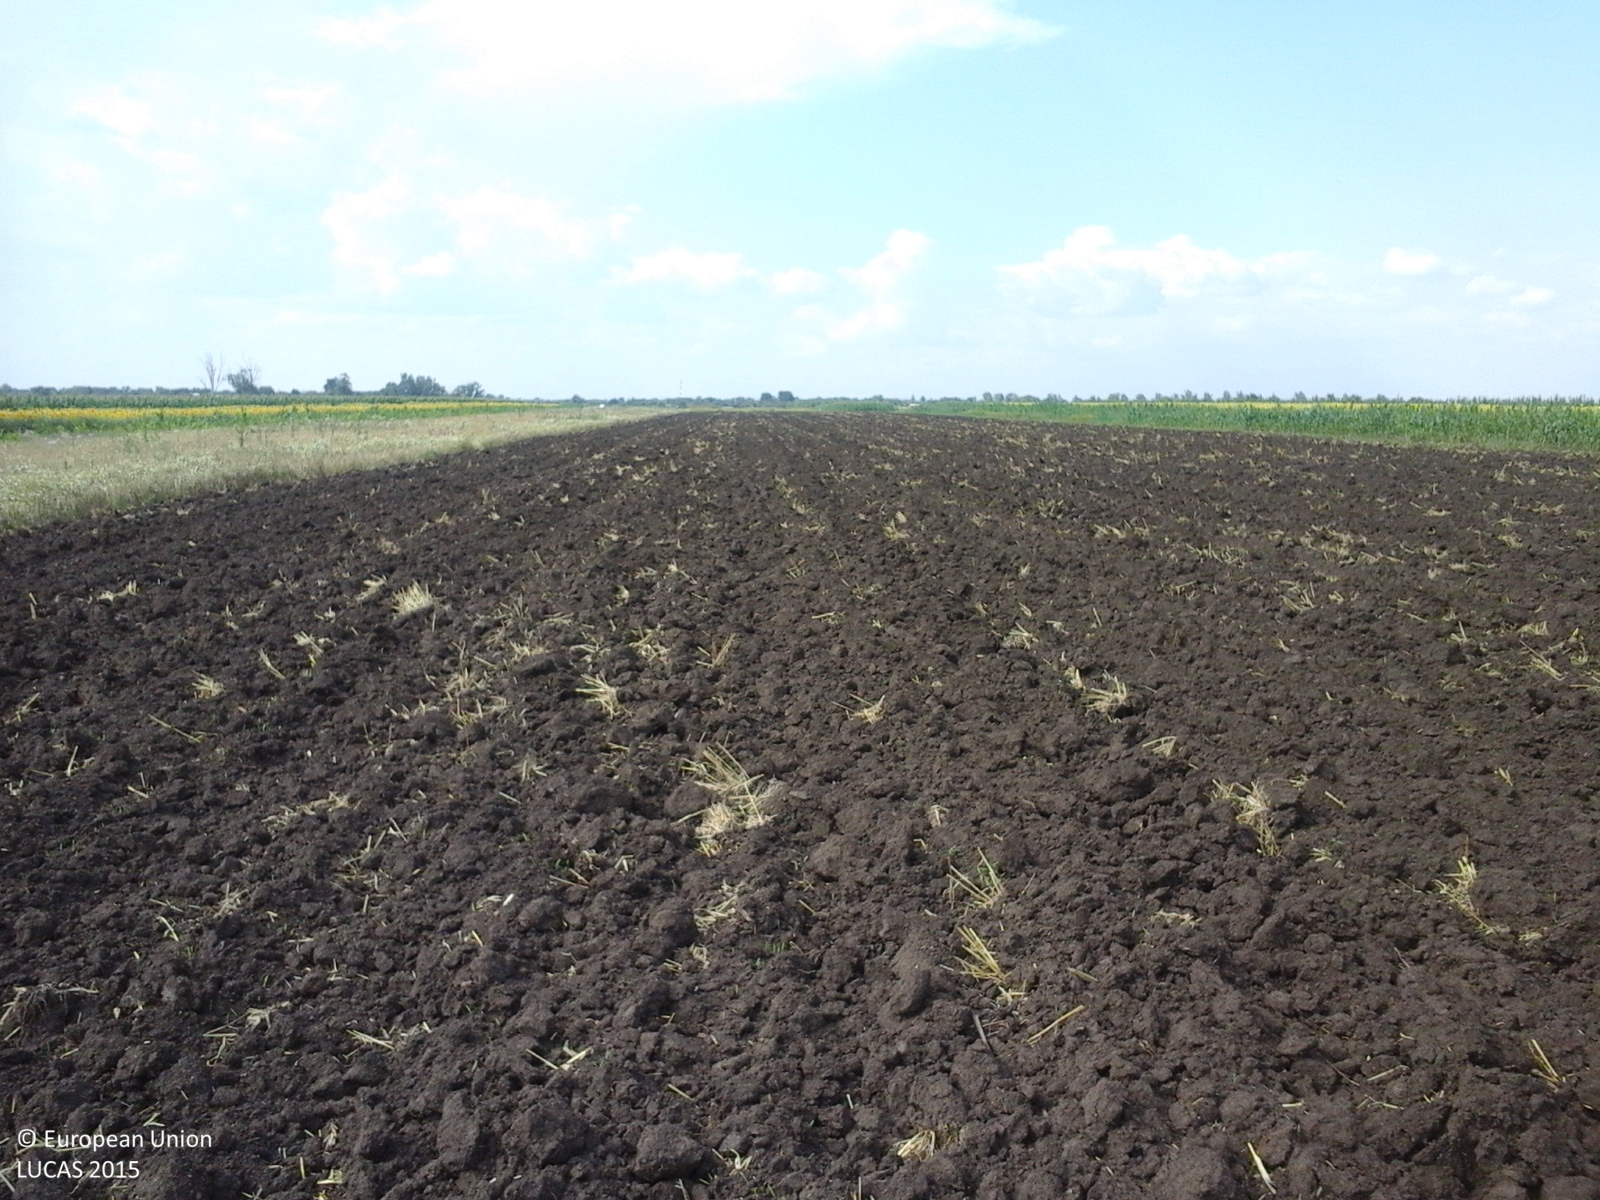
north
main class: Cropland
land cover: Common wheat
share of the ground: < 10 %
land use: Agriculture (excluding fallow land and kitchen gardens)
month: July
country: RO
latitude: 44.0159
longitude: 25.7732
